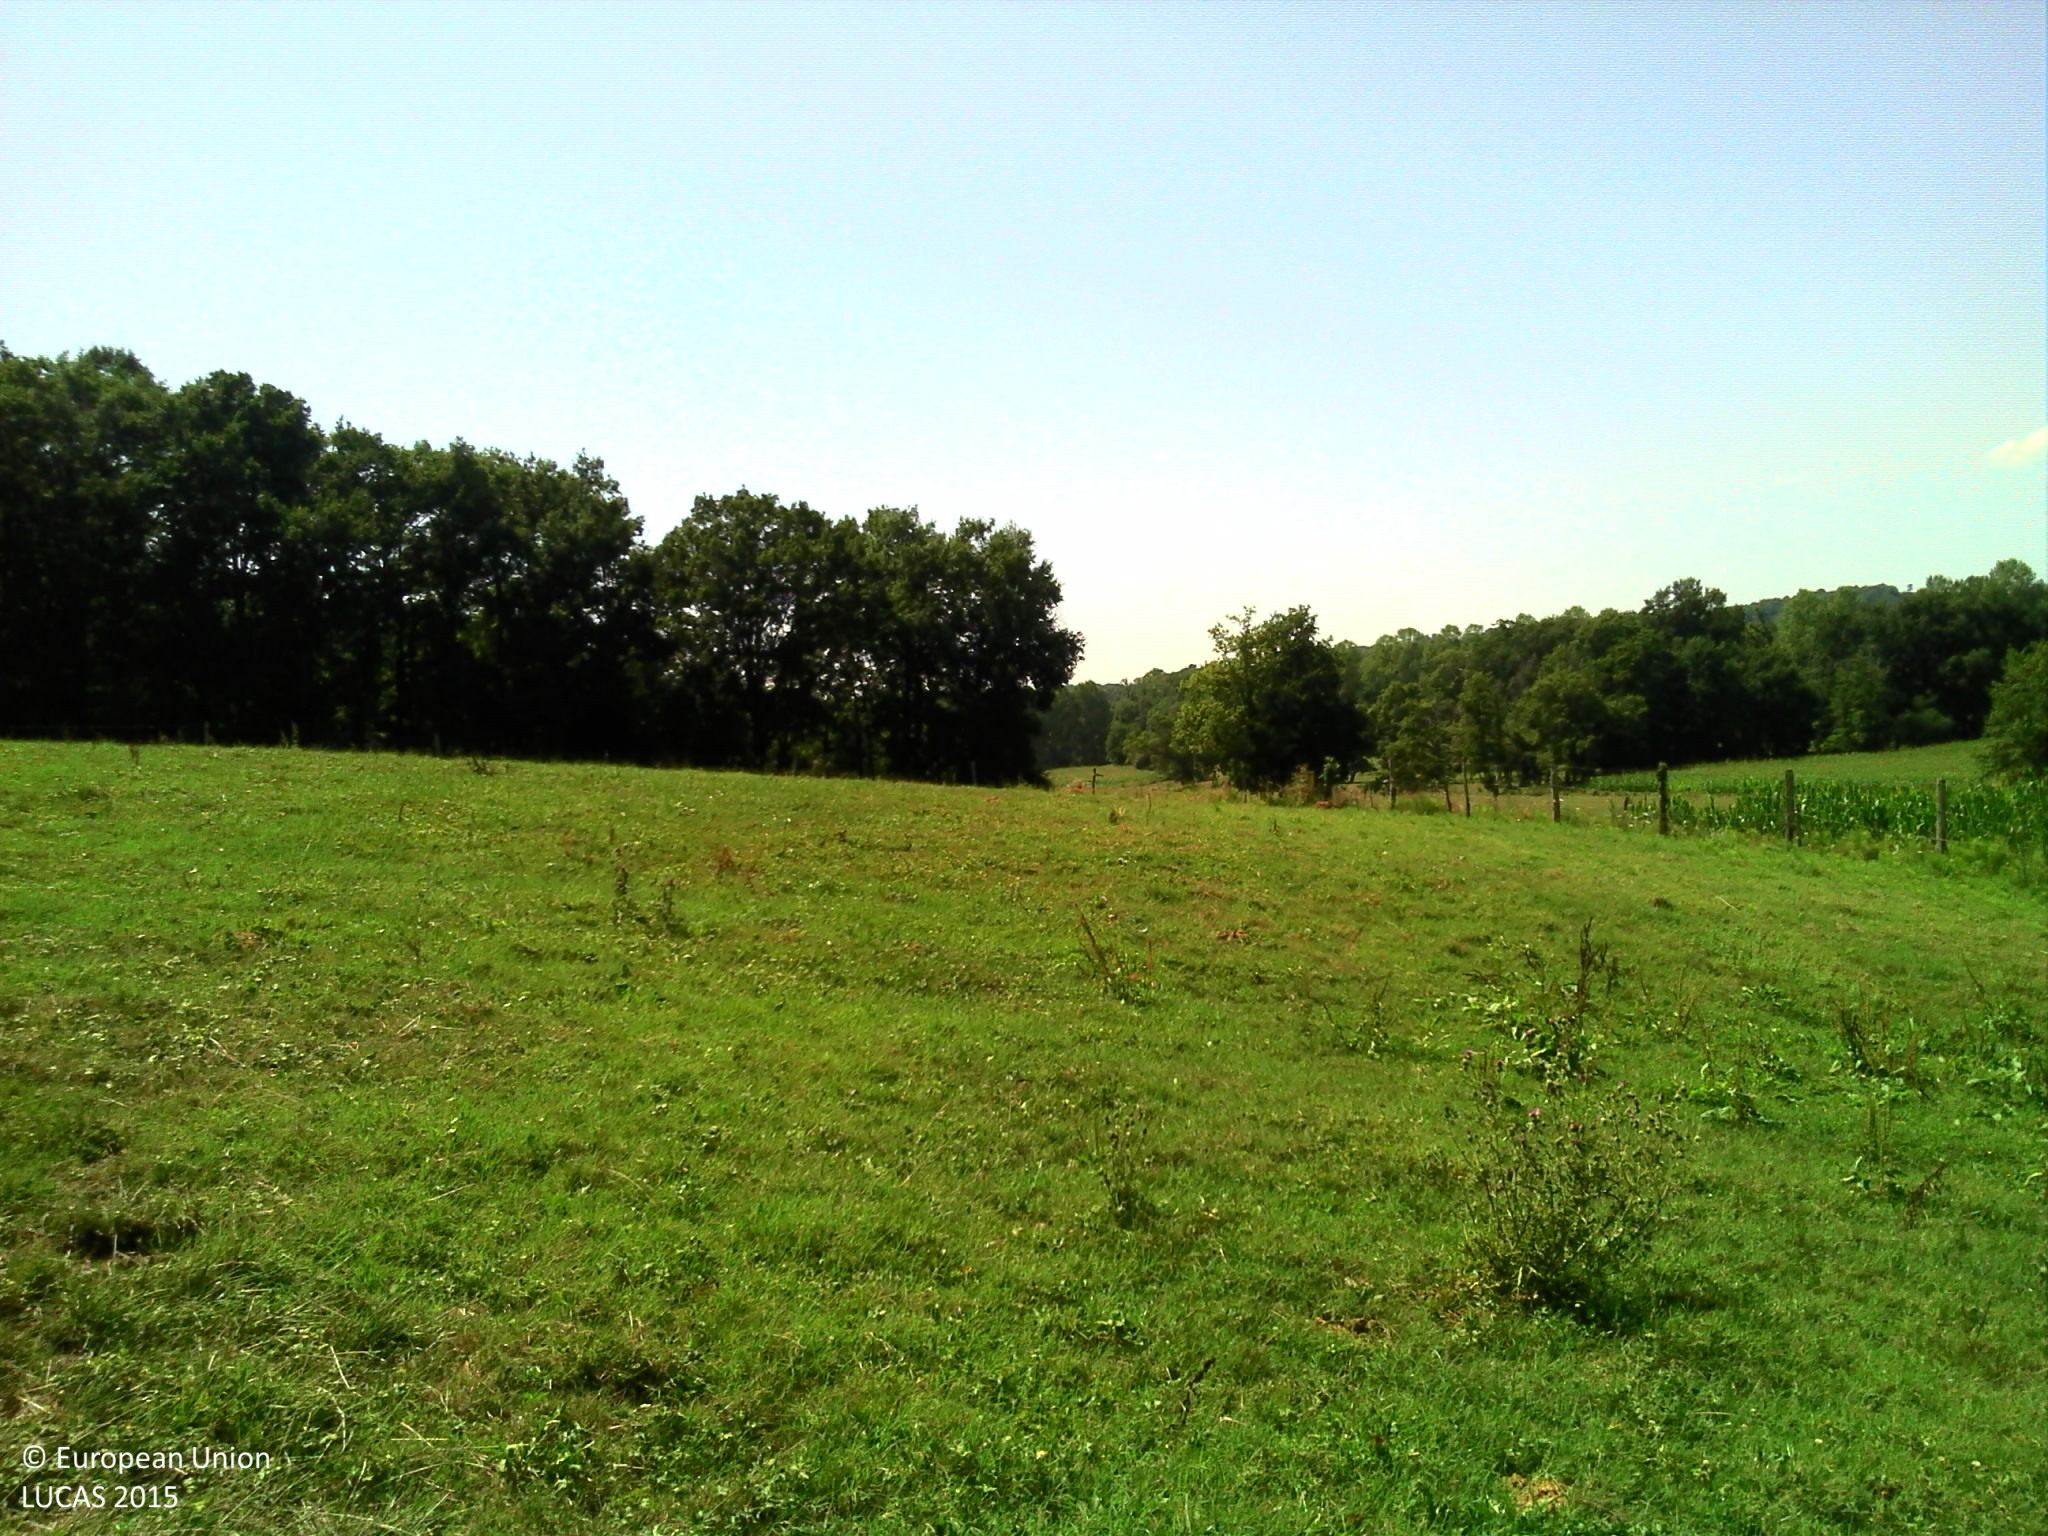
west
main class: Grassland
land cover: Grassland without tree/shrub cover
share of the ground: > 75 %
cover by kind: herbaceous plants 95 %, unconsolidated bare surface 5 %
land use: Agriculture (excluding fallow land and kitchen gardens)
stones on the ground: < 10 %
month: August
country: FR
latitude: 43.7204
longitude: -0.7249
